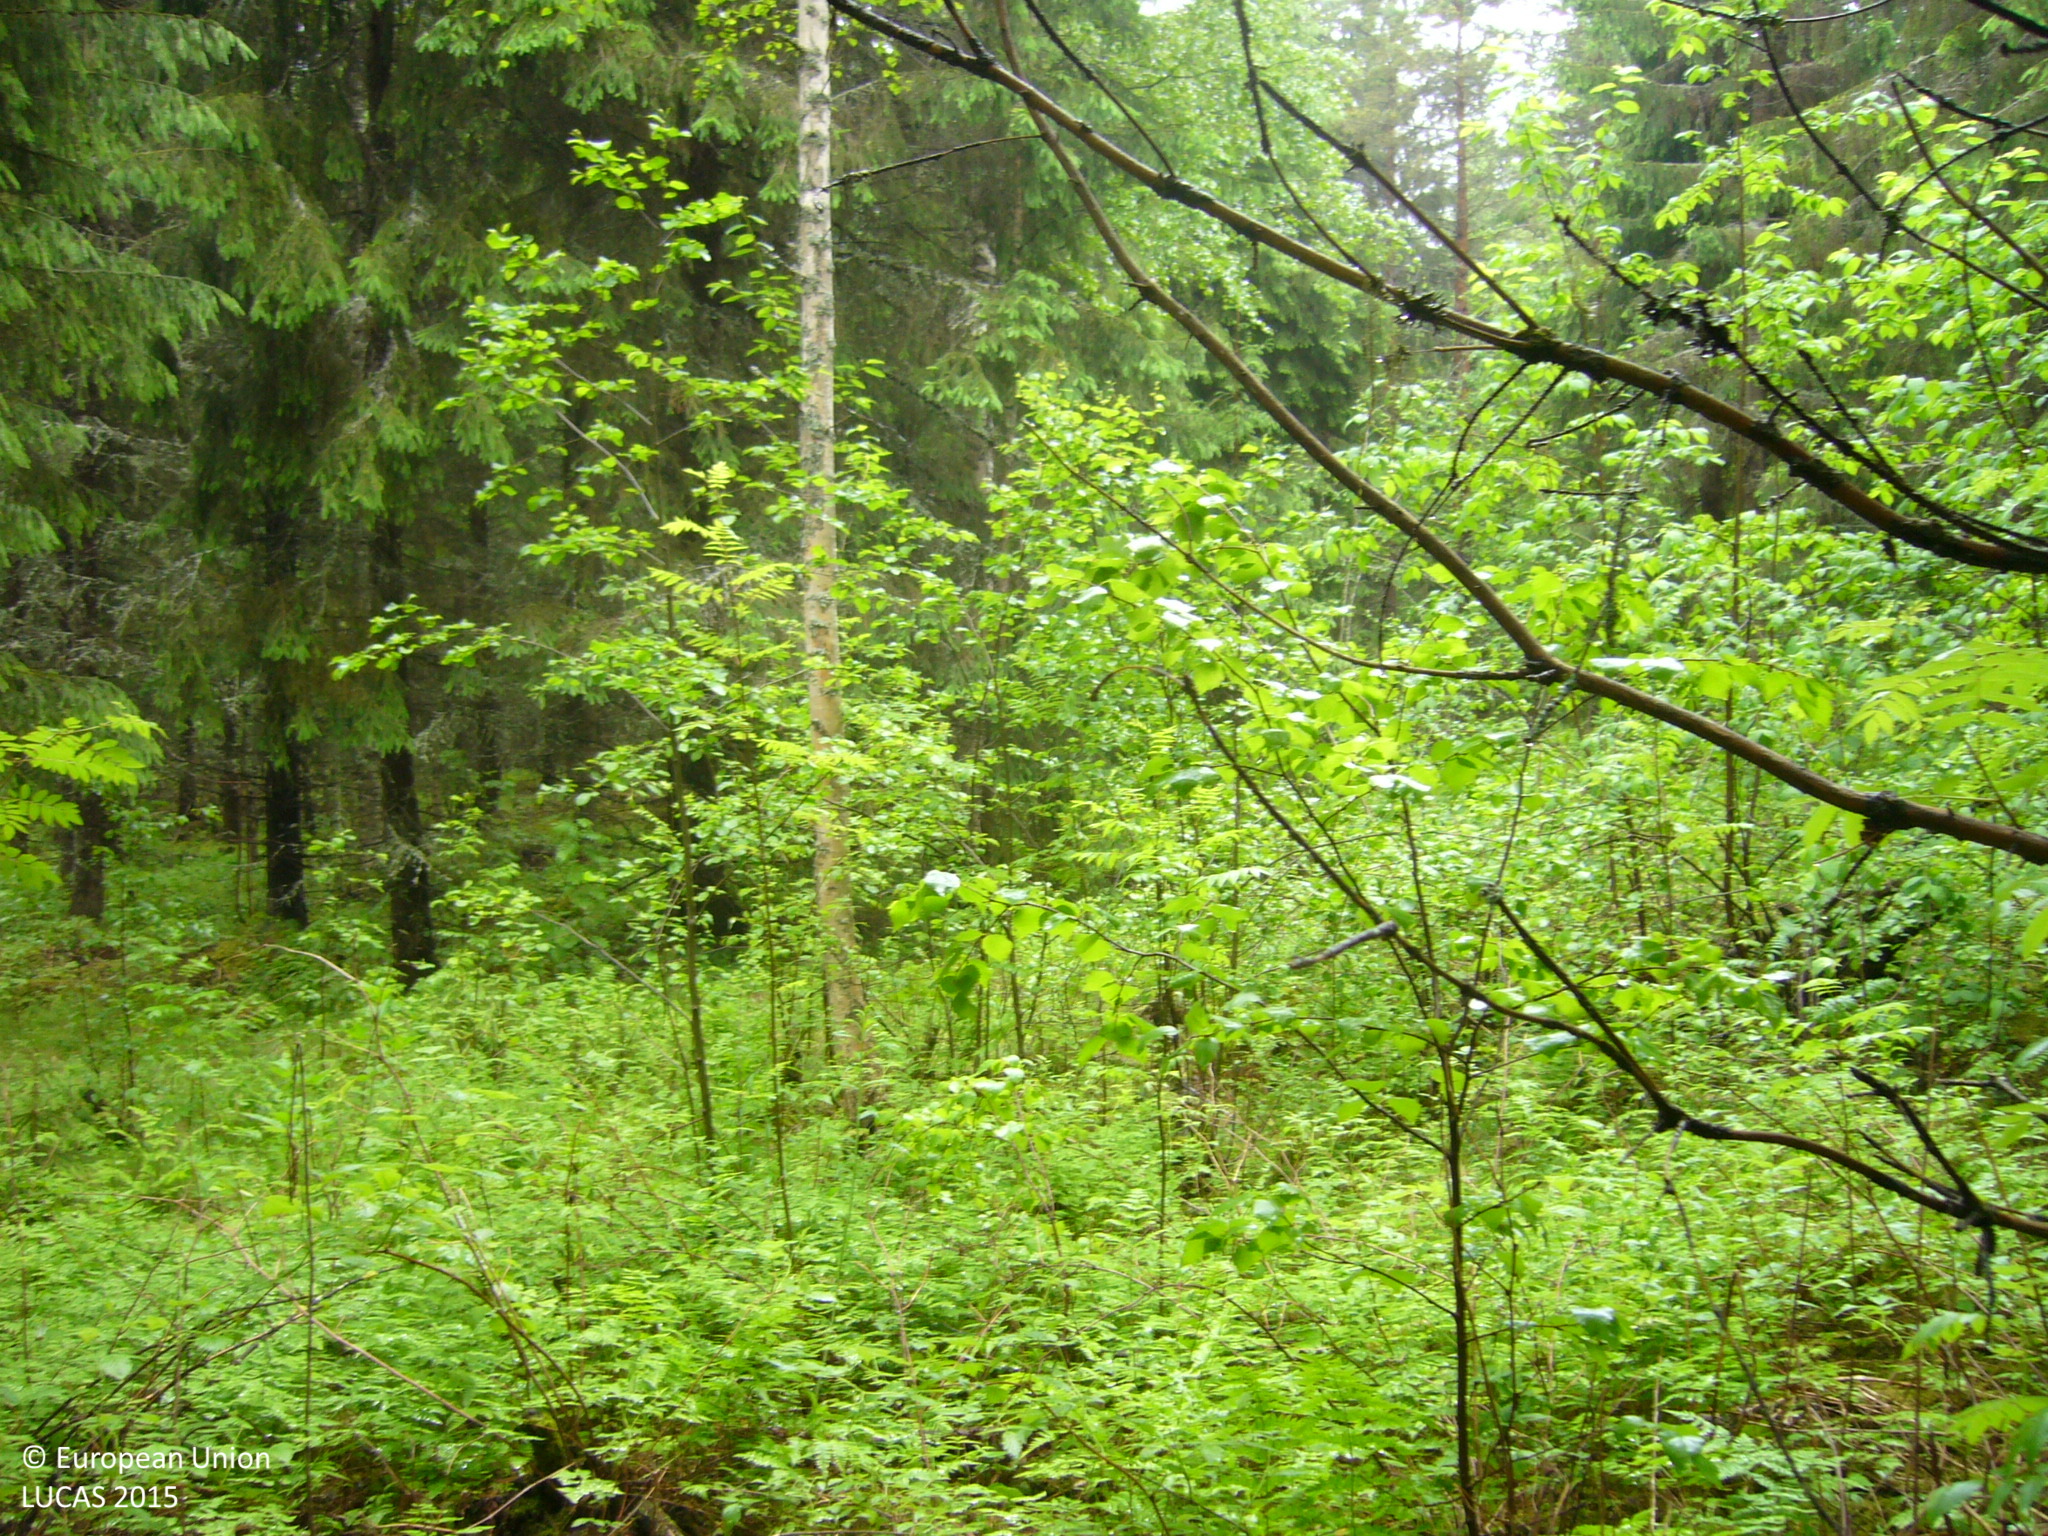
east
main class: Woodland
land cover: Spruce dominated mixed woodland
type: boreal forest
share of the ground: > 75 %
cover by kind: coniferous forest trees 55 %, broadleaved forest trees 25 %, shrubs 20 %
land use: Forestry
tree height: > 5 m
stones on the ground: < 10 %
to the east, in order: Spruce dominated mixed woodland; Spruce dominated coniferous woodland; Tracks; Spruce dominated mixed woodland; Ditches and canals; Broadleaved woodland
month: June
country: FI
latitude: 63.6501
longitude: 26.5437
